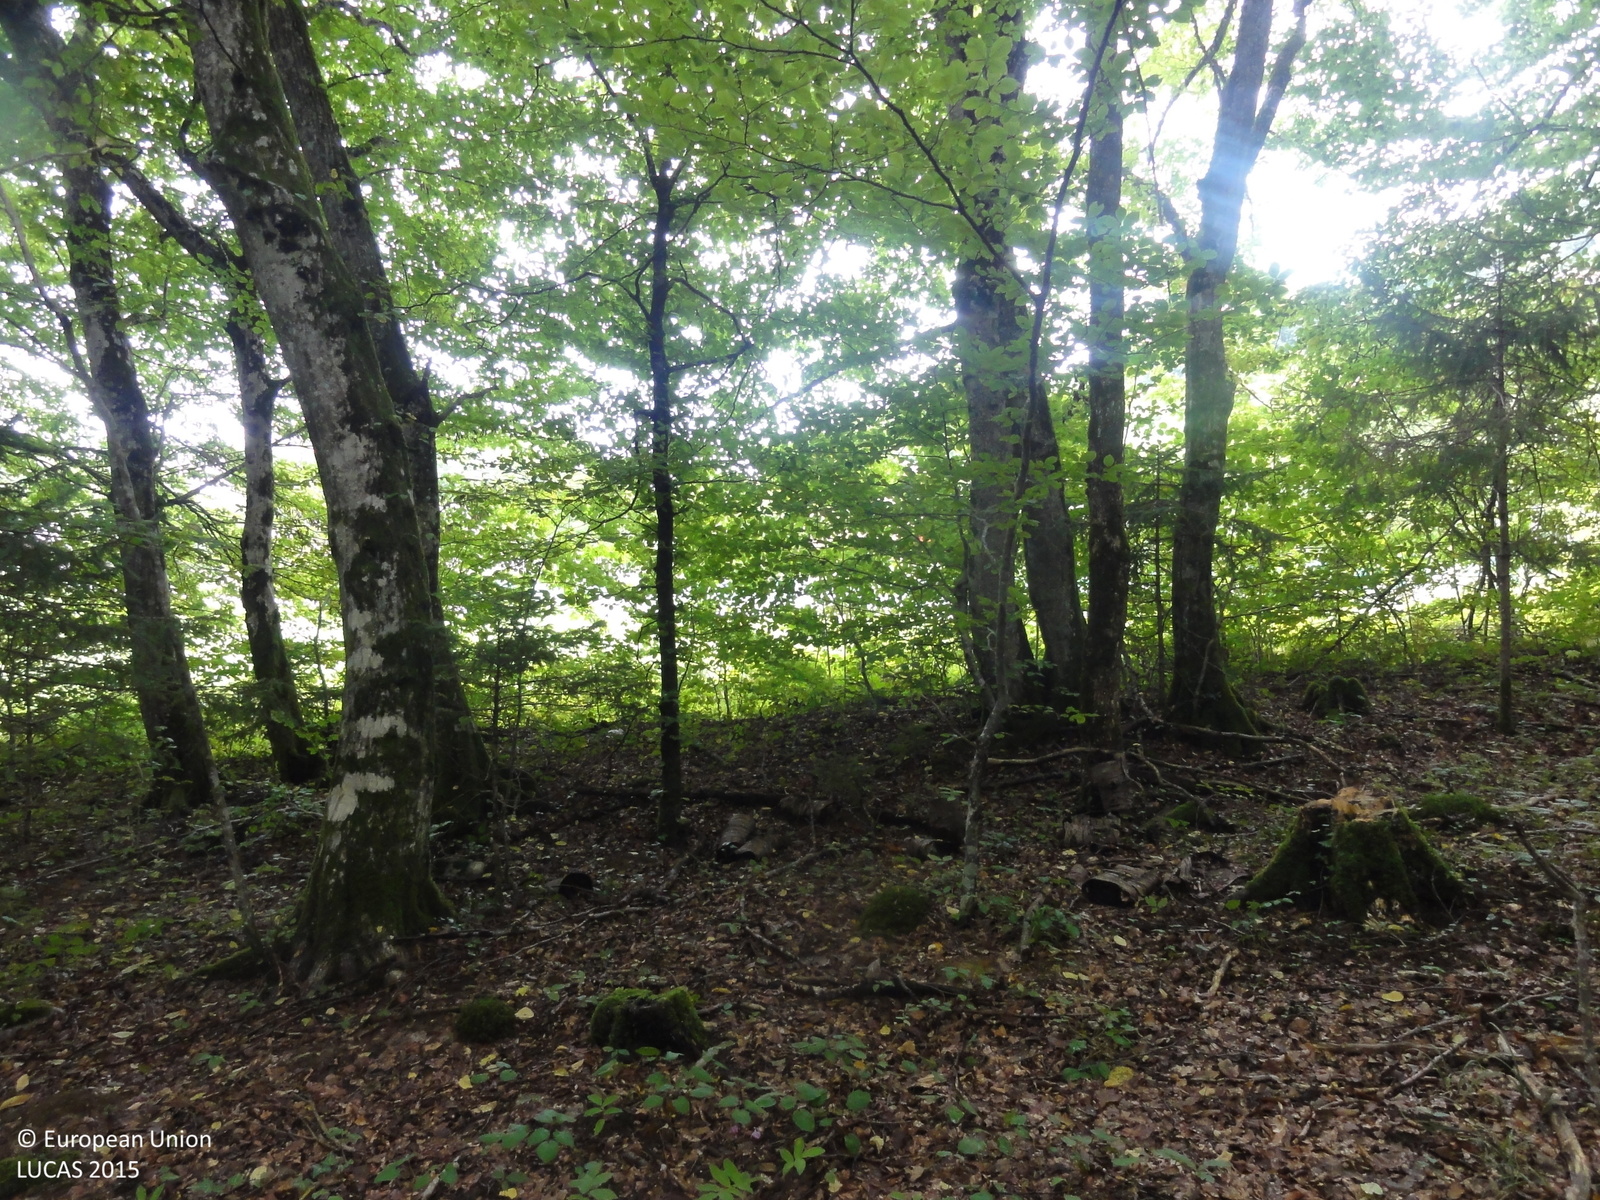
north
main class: Woodland
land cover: Broadleaved woodland
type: beech forest
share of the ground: > 75 %
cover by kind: broadleaved forest trees 95 %, coniferous forest trees 5 %
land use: Forestry
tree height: > 5 m
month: August
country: SI
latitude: 45.7423
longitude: 15.0989
